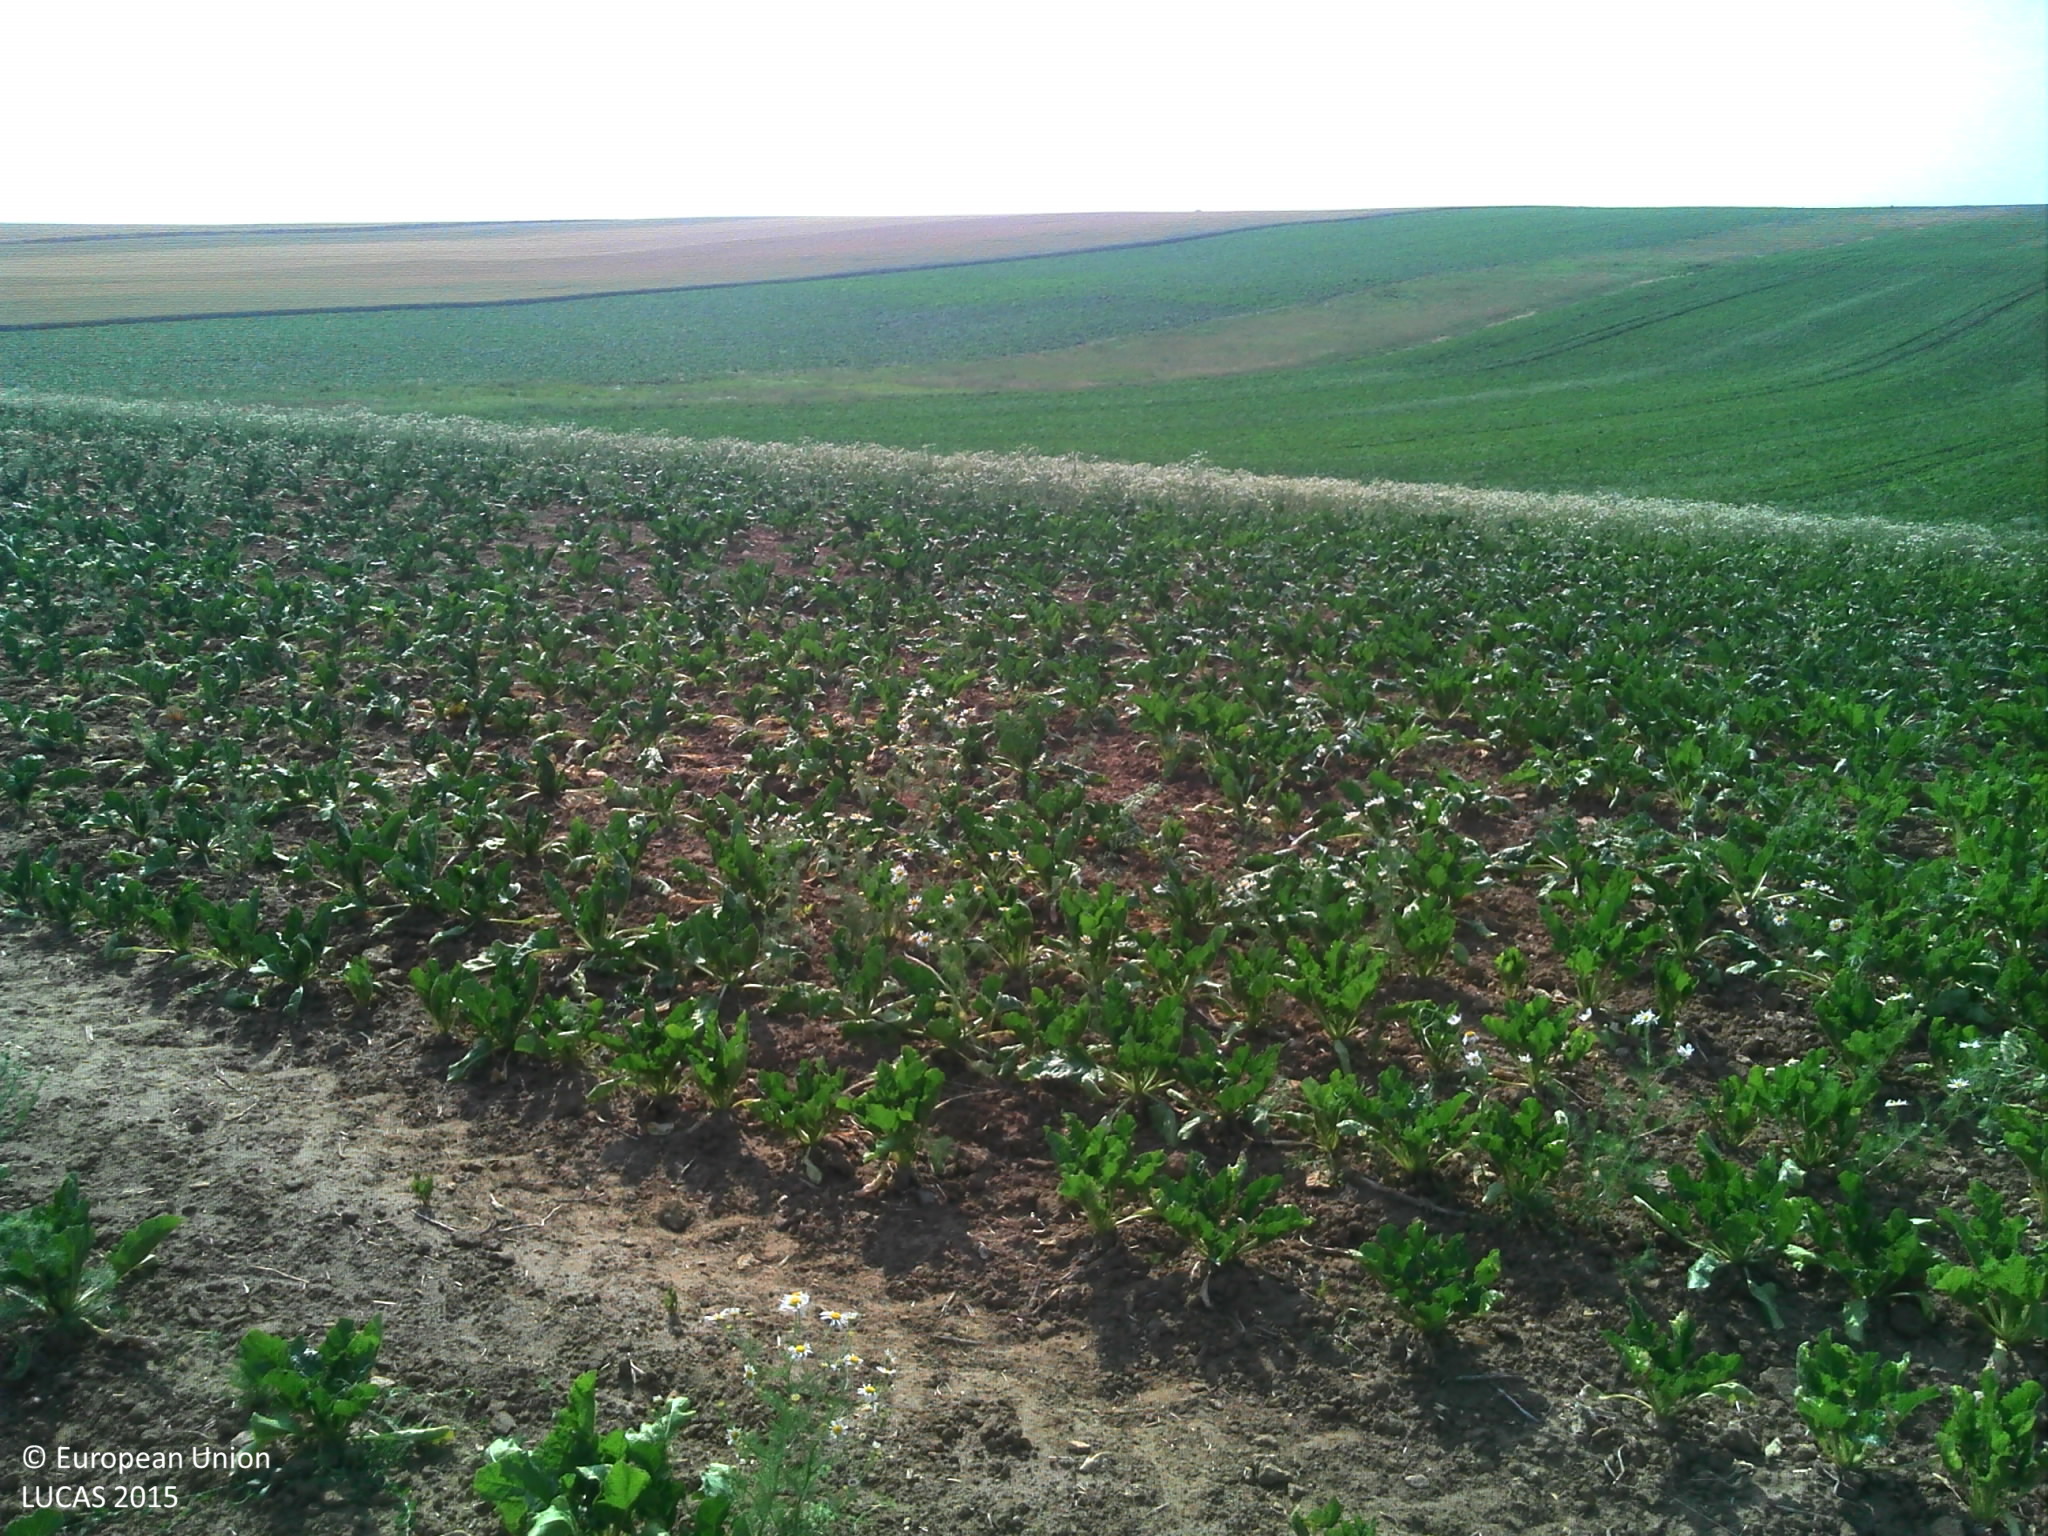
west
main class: Cropland
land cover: Sugar beet
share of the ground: 50 - 75 %
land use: Agriculture (excluding fallow land and kitchen gardens)
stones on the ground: < 10 %
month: July
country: FR
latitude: 49.1595
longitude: 3.3418
